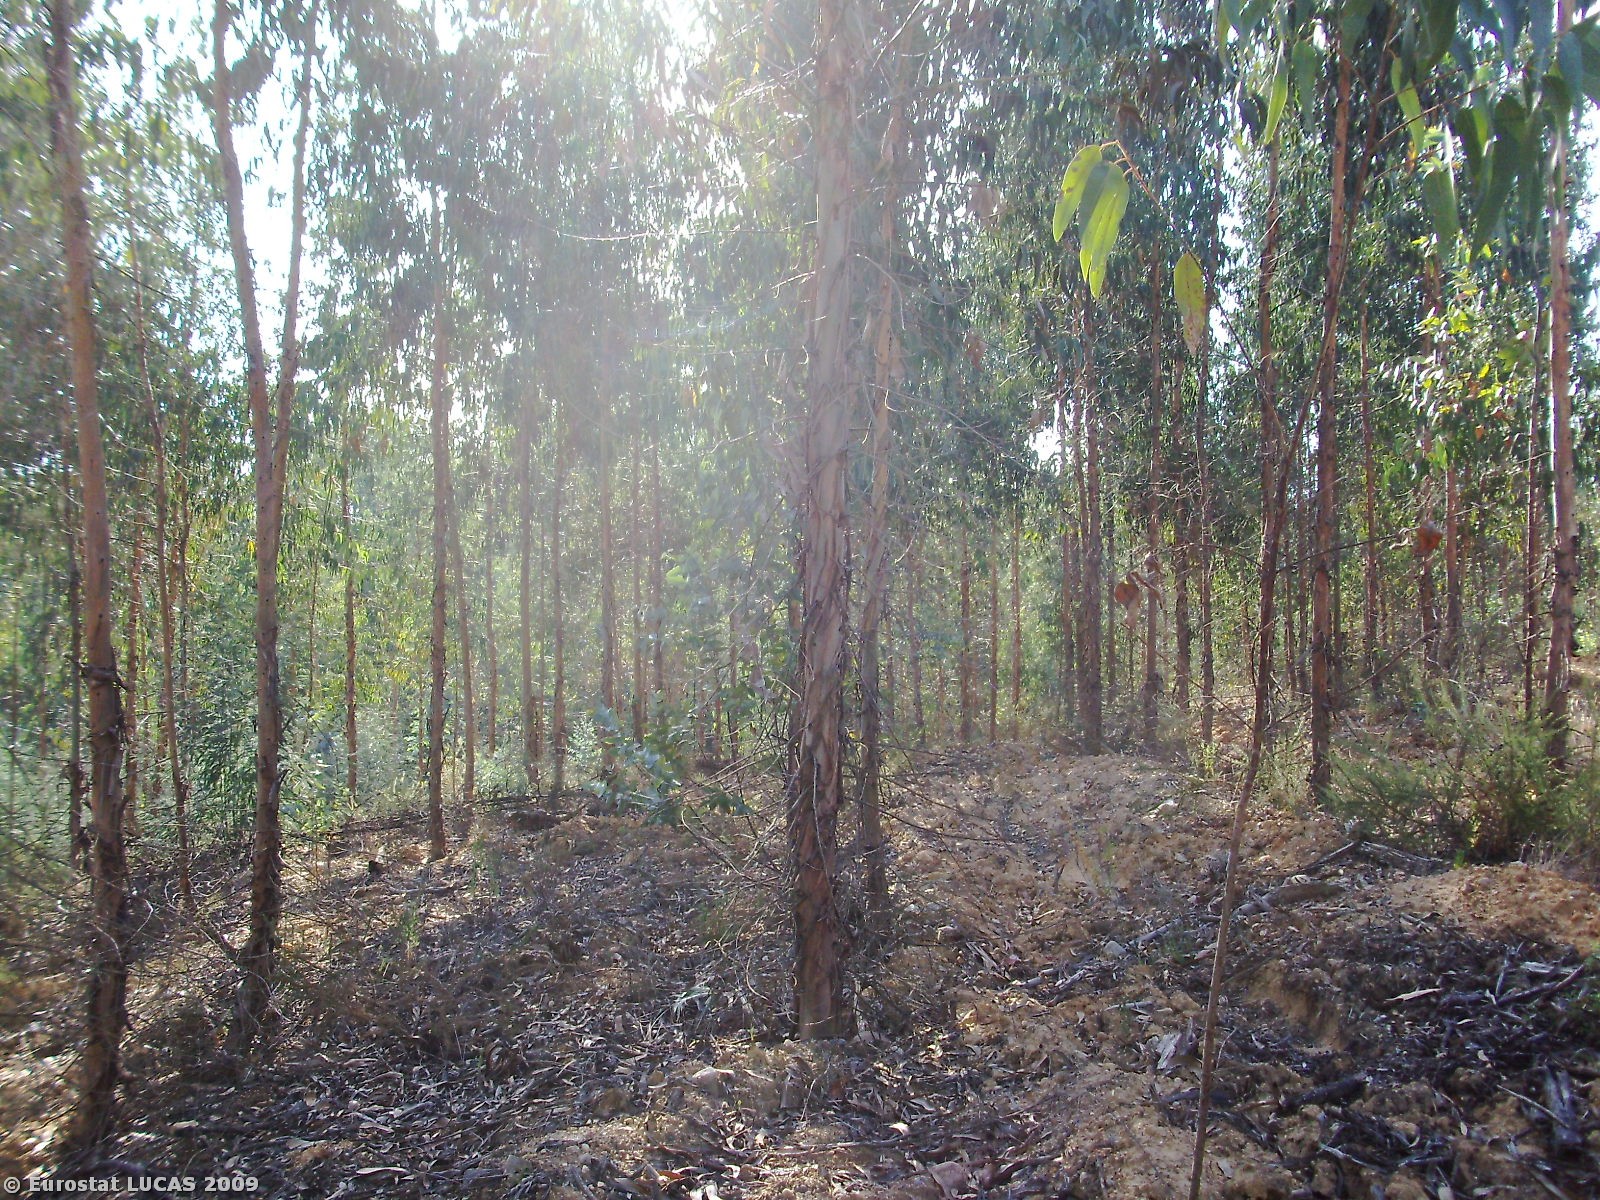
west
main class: Woodland
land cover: Broadleaved woodland
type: plantations and self-sown exotic forest
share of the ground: > 75 %
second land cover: Bare land
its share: 10 - 25 %
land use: Forestry
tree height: > 5 m
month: July
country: PT
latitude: 39.3532
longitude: -8.8201
